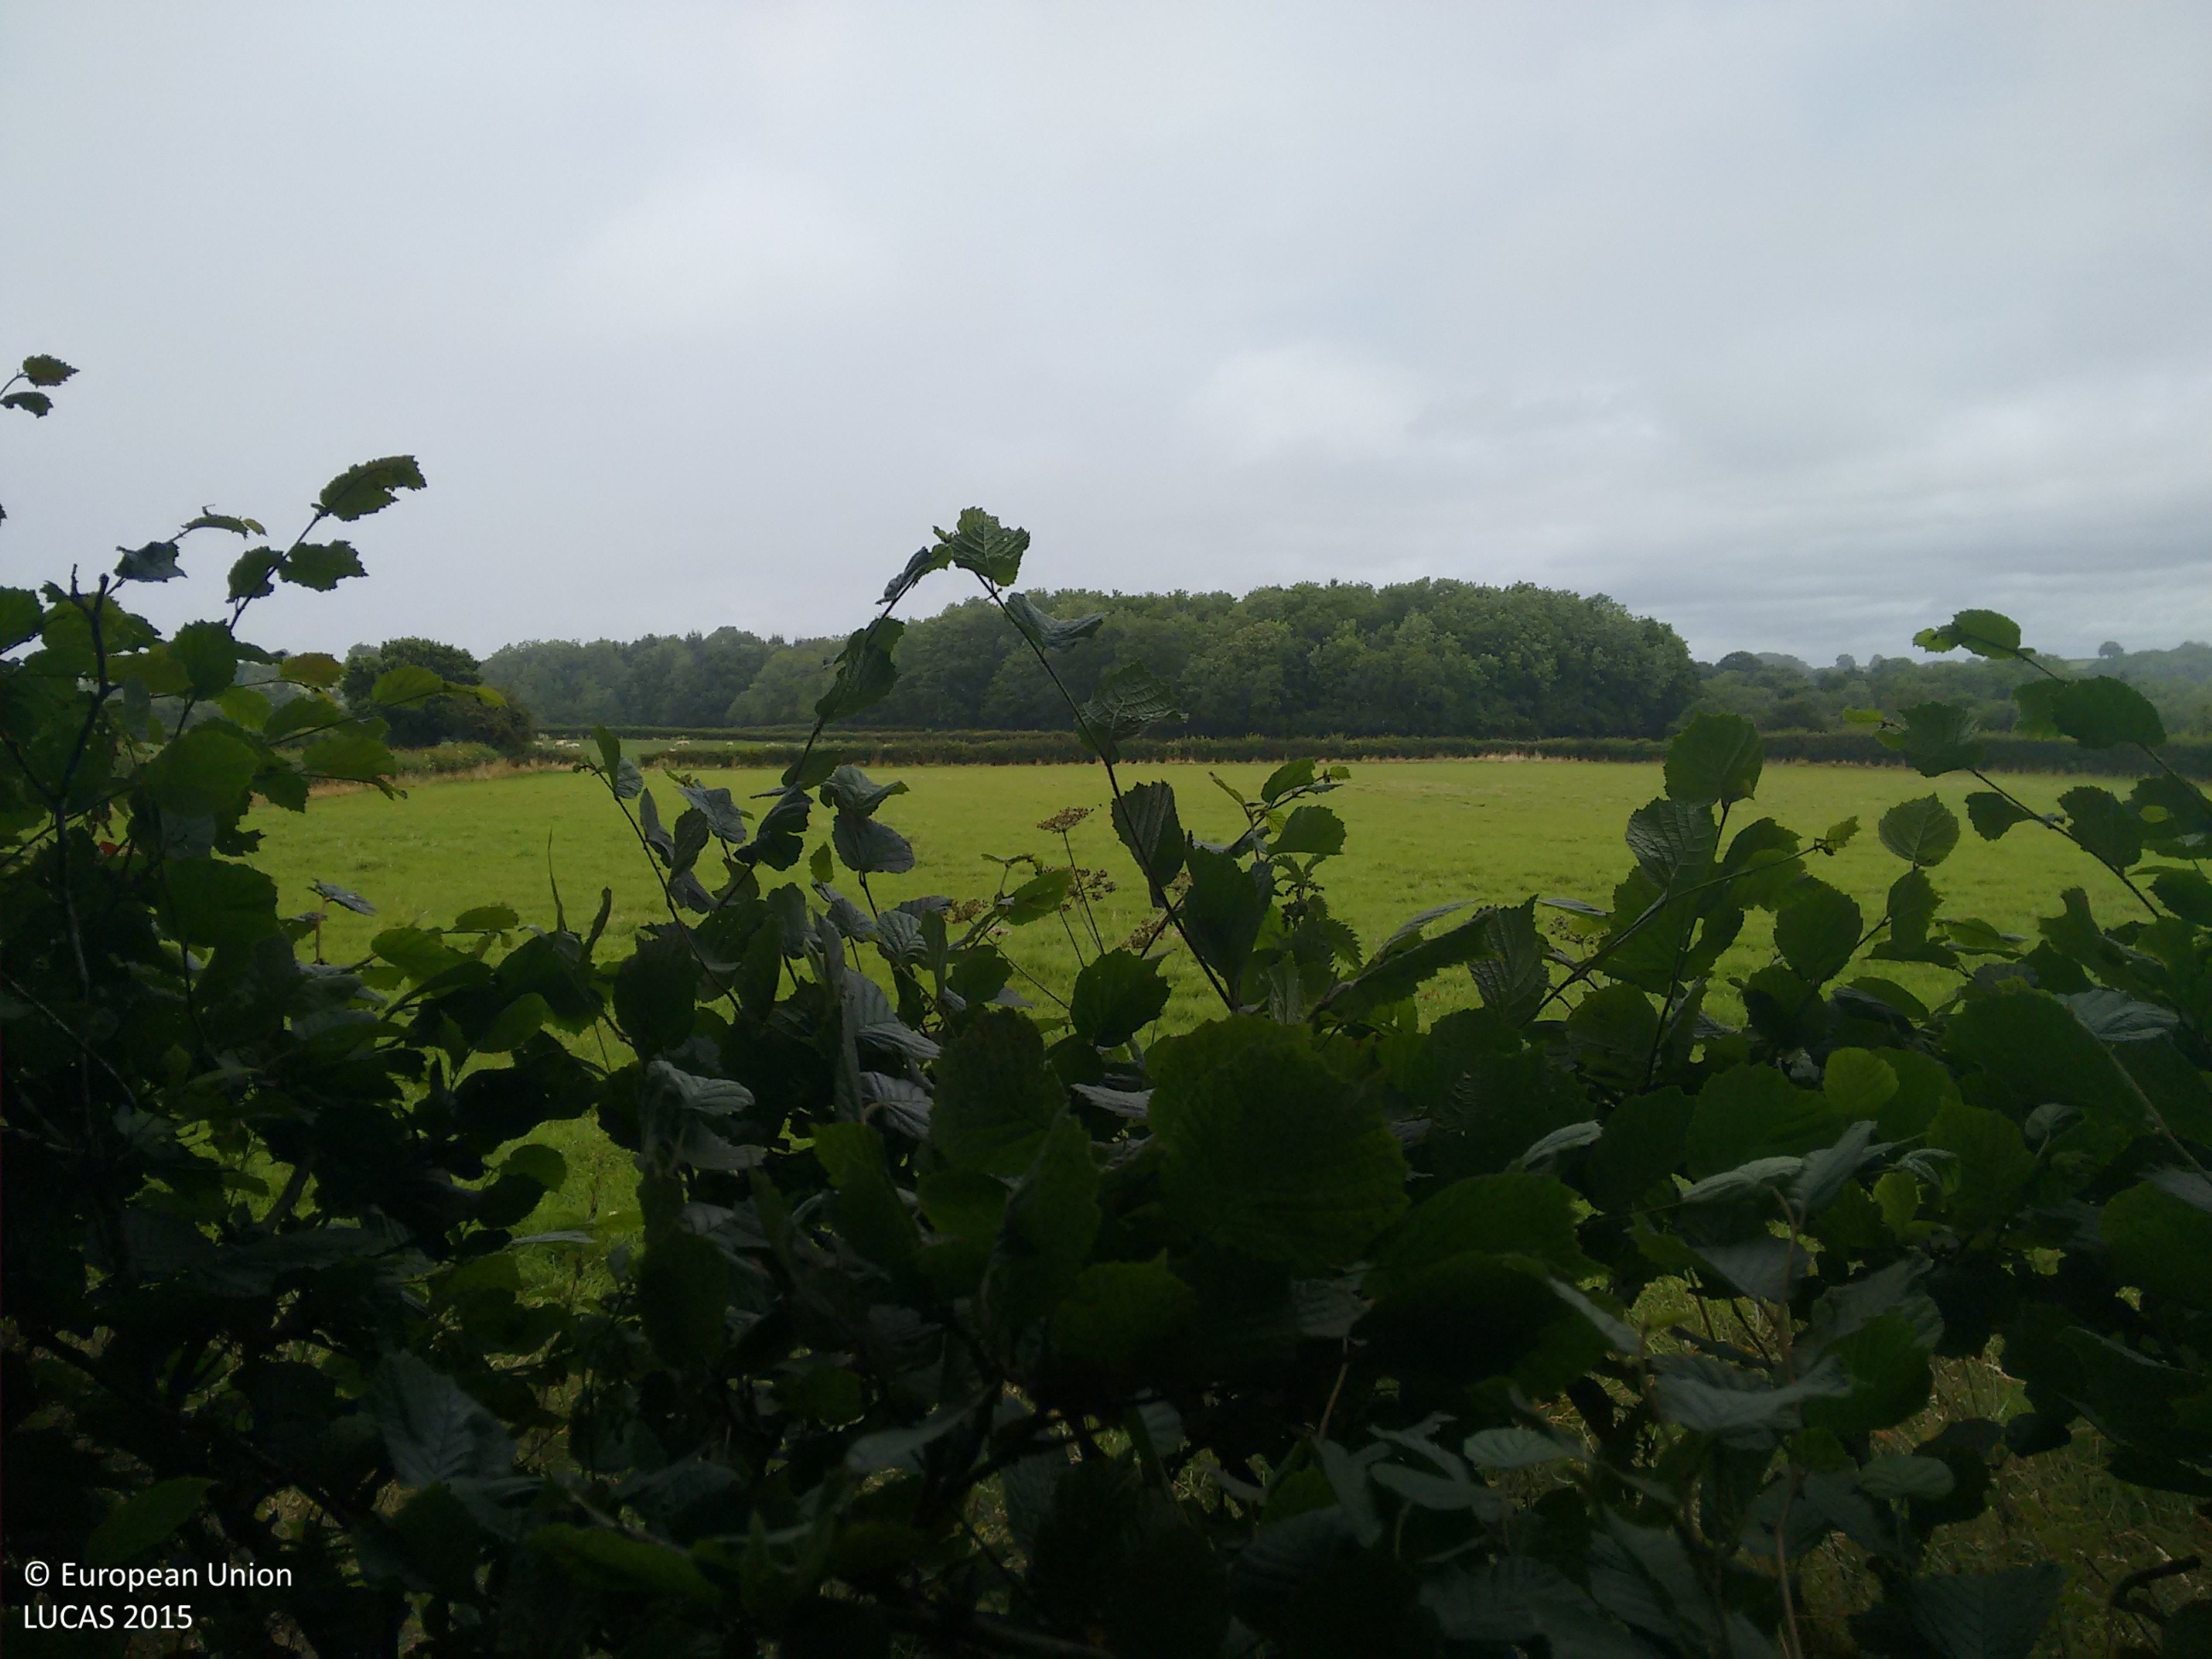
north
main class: Grassland
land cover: Grassland without tree/shrub cover
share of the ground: > 75 %
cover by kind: herbaceous plants 100 %
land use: Agriculture (excluding fallow land and kitchen gardens)
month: August
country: GB
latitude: 51.9908
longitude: -2.9626
